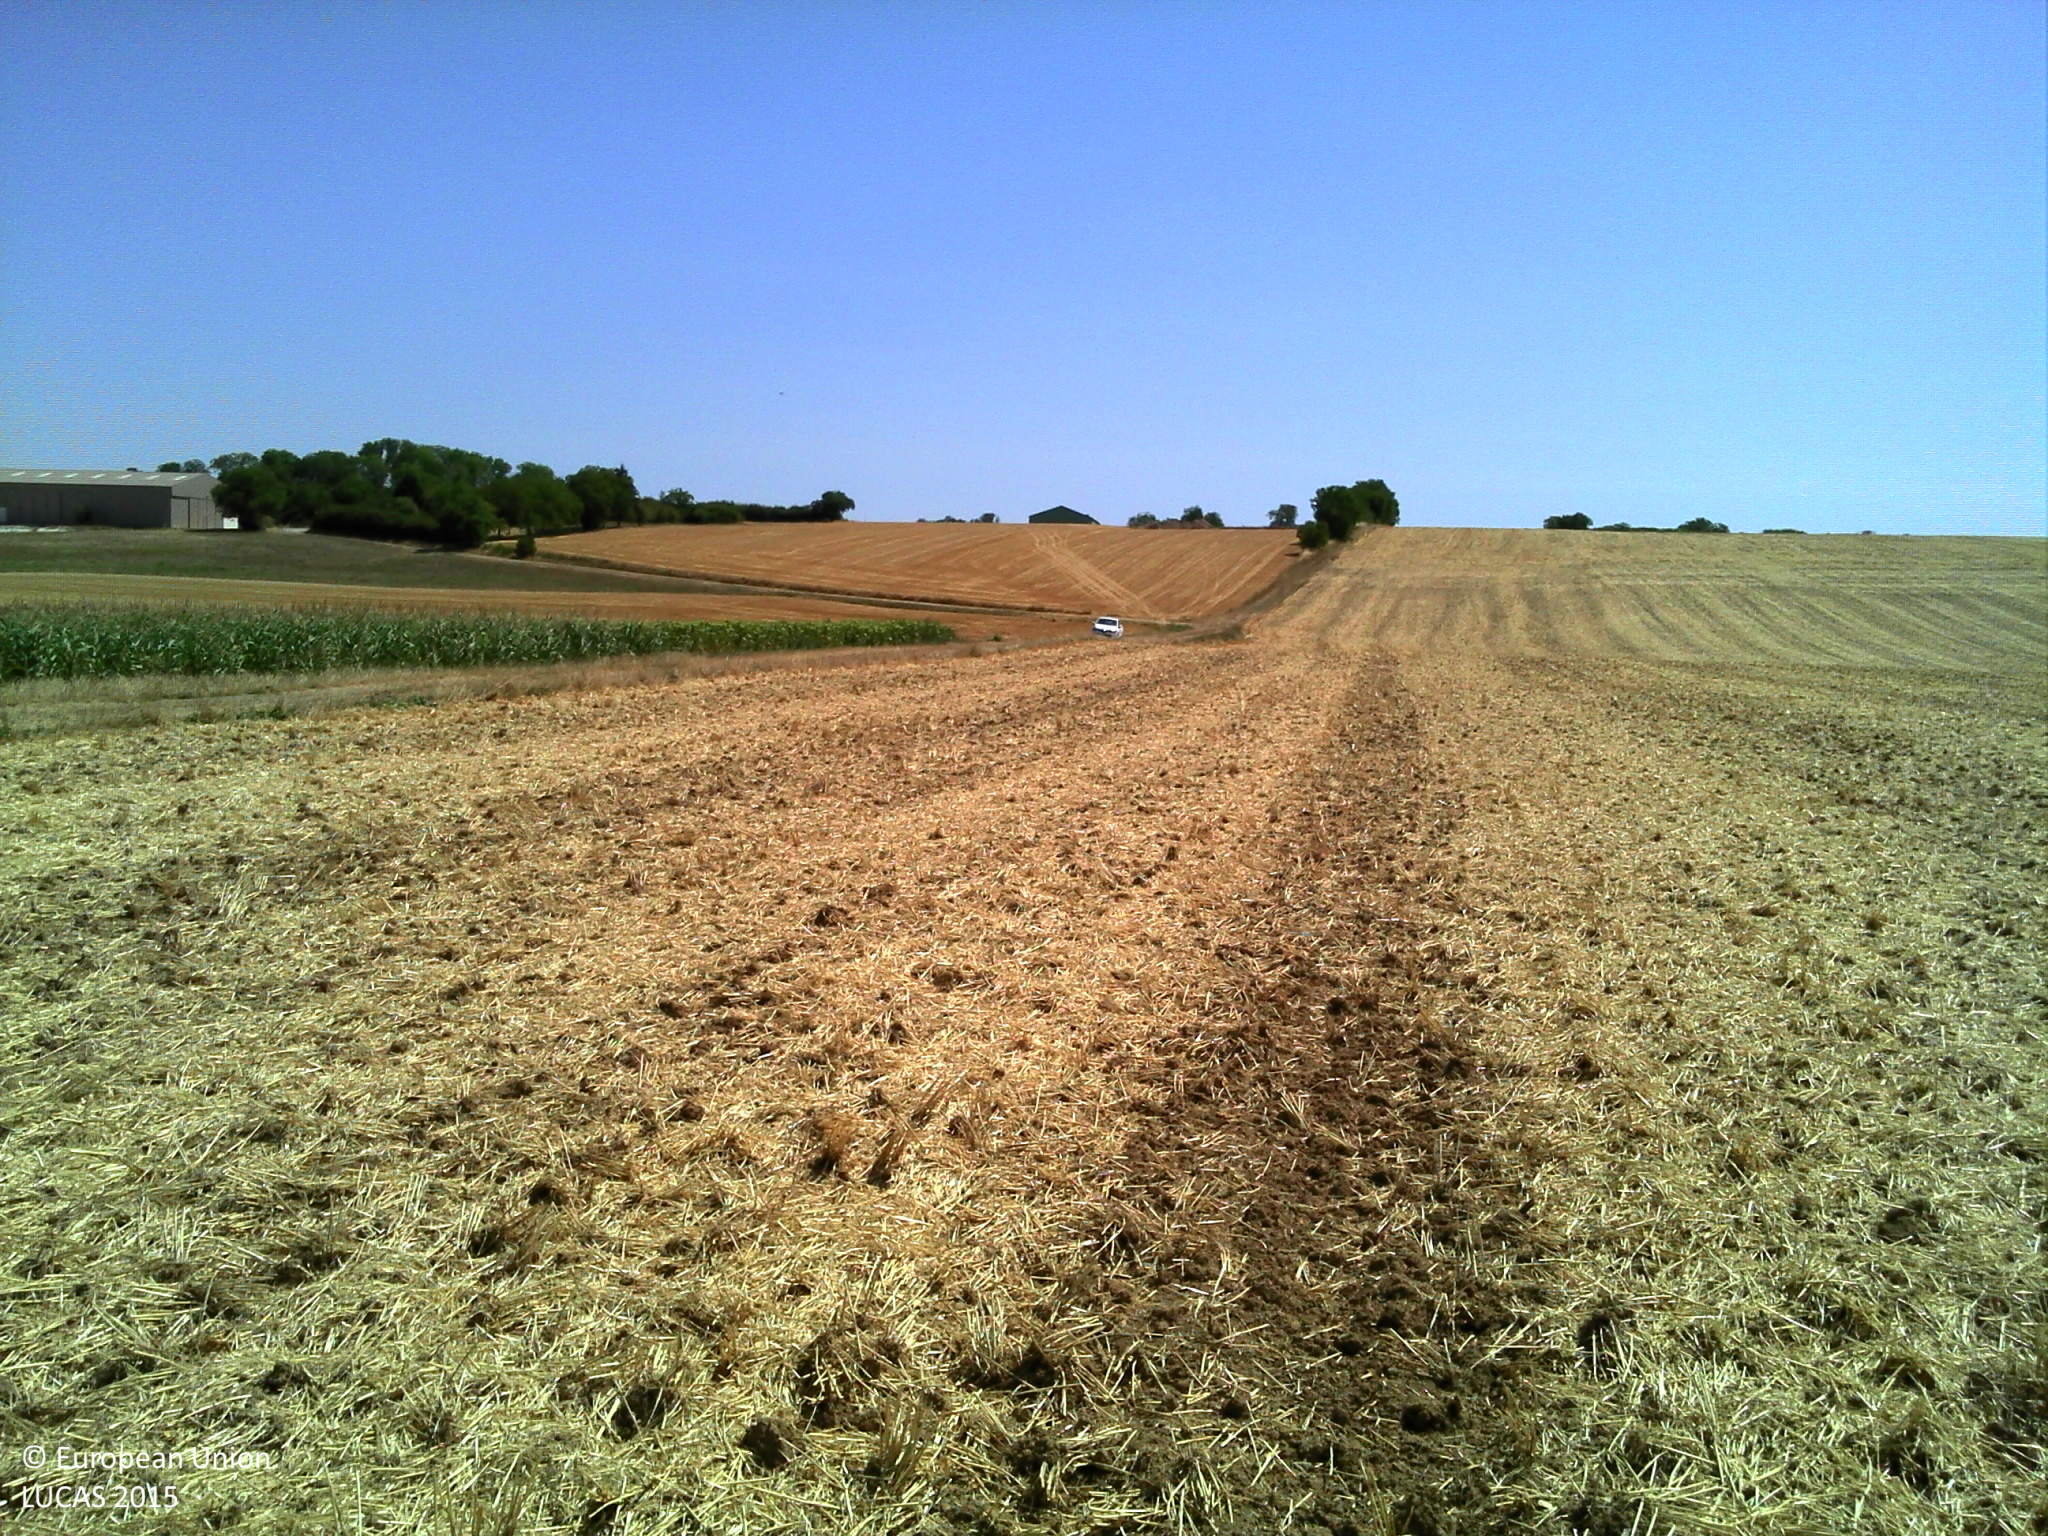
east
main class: Cropland
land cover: Common wheat
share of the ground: > 75 %
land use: Agriculture (excluding fallow land and kitchen gardens)
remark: Tilled/Sowed
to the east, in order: Common wheat; Grass margins; Tracks; Grass margins; Sunflower; Common wheat; Grass margins; Tracks; Grass margins; Common wheat
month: August
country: FR
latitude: 47.9189
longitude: 3.4245
